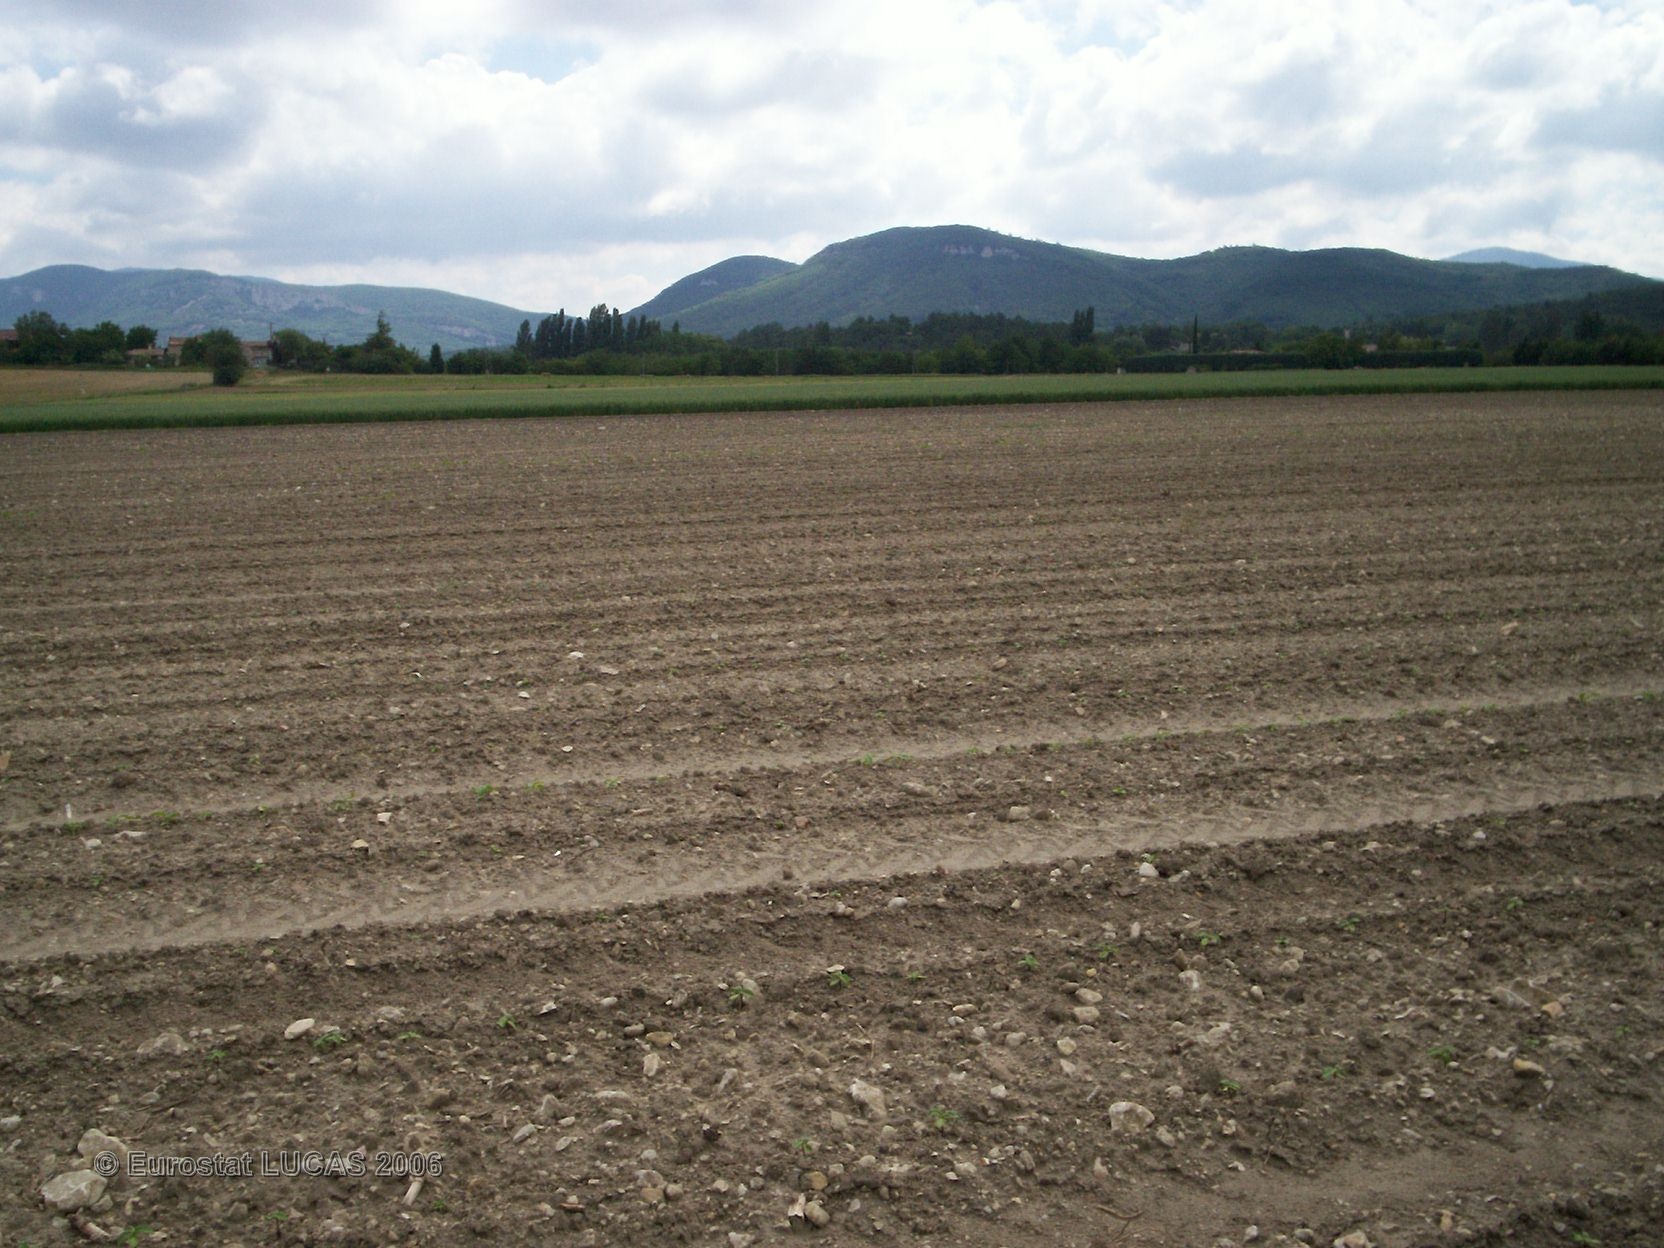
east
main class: Cropland
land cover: Sunflower
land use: Agriculture (excluding fallow land and kitchen gardens)
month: June
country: FR
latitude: 44.5328
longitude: 4.9103
